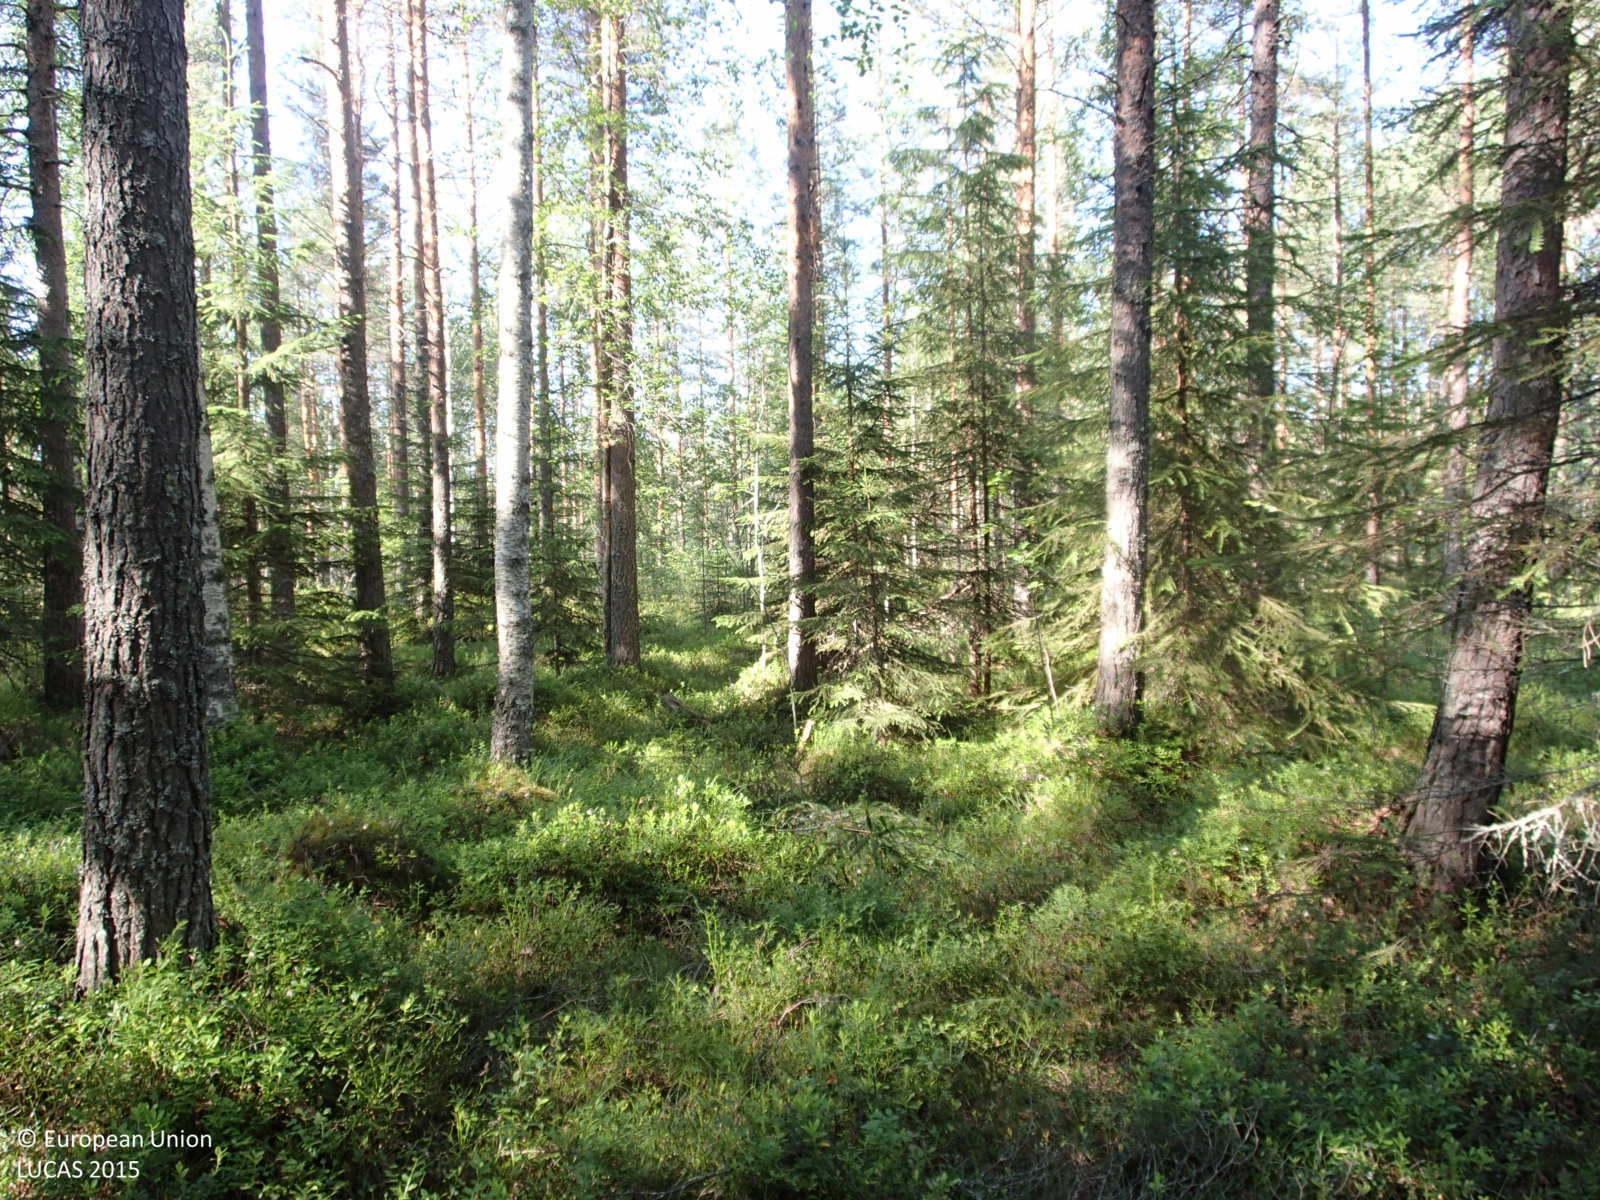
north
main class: Woodland
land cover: Other mixed woodland
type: boreal forest
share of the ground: > 75 %
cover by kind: coniferous forest trees 60 %, broadleaved forest trees 20 %, shrubs 20 %
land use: Forestry
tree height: > 5 m
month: July
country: FI
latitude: 64.1166
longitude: 27.2007
